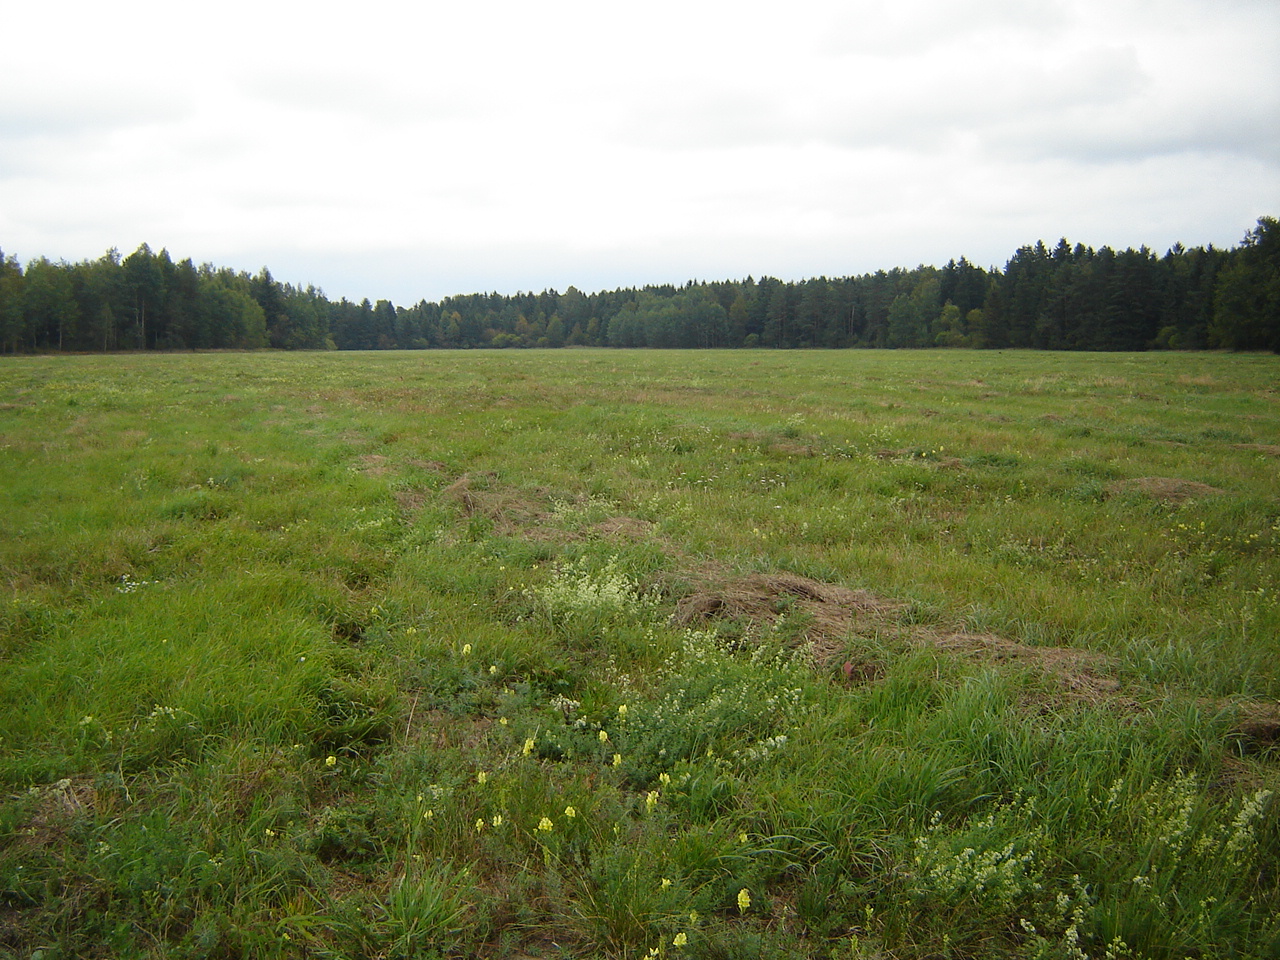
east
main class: Grassland
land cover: Grassland without tree/shrub cover
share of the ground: > 75 %
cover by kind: herbaceous plants 100 %
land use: Agriculture (excluding fallow land and kitchen gardens)
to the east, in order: Grassland without tree/shrub cover
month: September
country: LT
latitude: 54.4006
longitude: 24.8531
